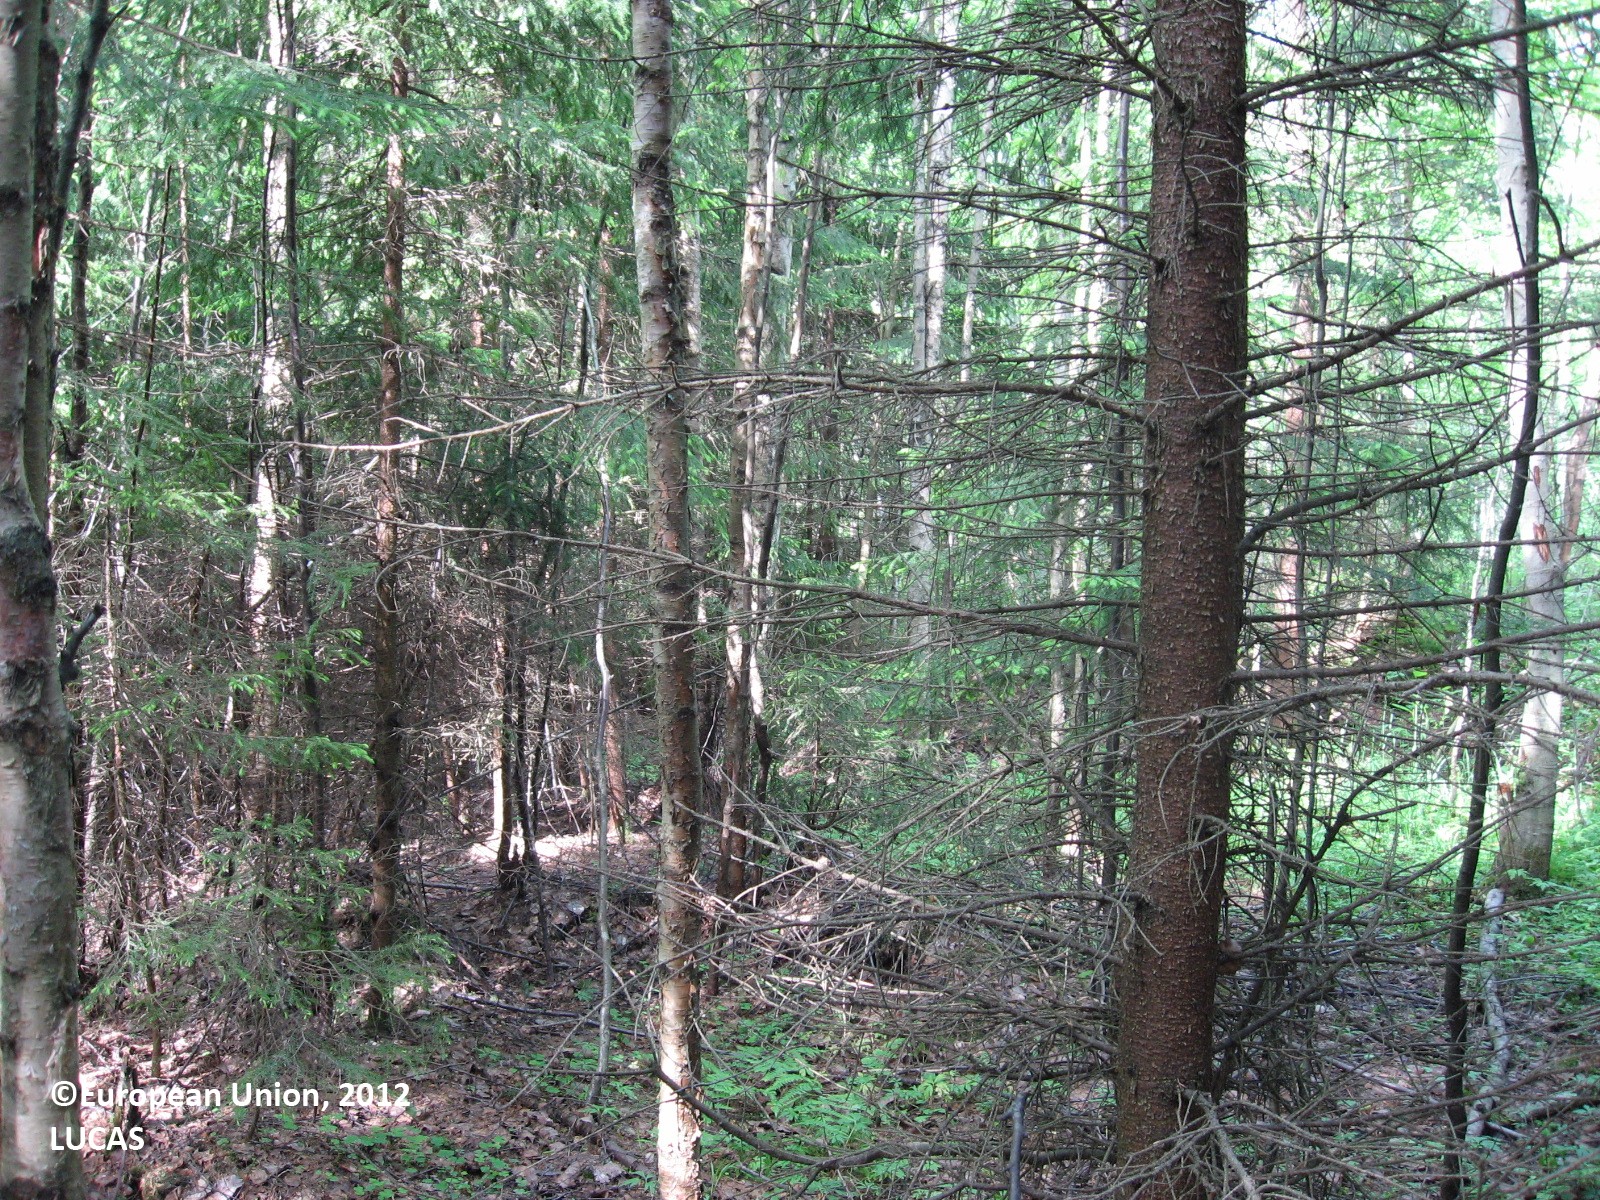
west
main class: Woodland
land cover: Spruce dominated coniferous woodland
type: boreal forest
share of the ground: > 75 %
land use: Forestry
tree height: > 5 m
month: June
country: FI
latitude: 60.3539
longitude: 24.9241
